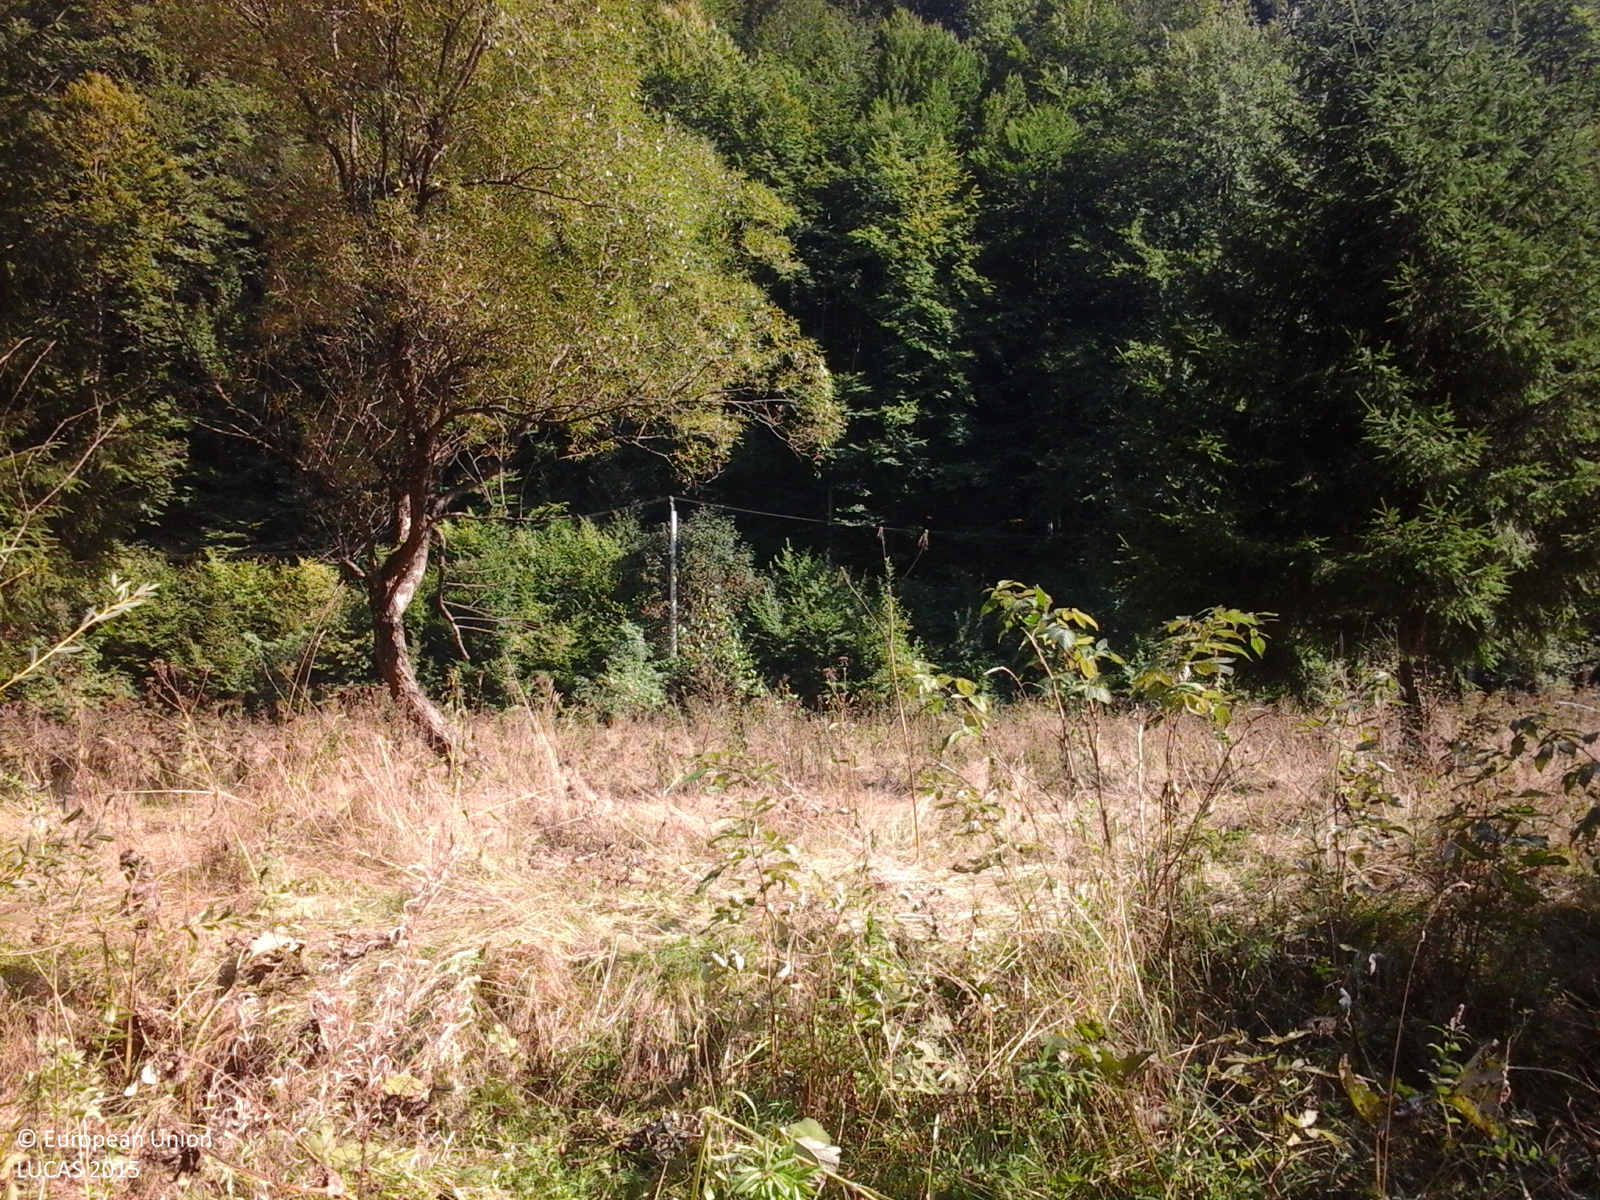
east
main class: Woodland
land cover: Other mixed woodland
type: acidophilous oak and oak-birch forest
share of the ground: > 75 %
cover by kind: broadleaved forest trees 75 %, coniferous forest trees 25 %
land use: Forestry
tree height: > 5 m
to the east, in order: Other mixed woodland; Inland fresh running water; Grassland with sparse tree/shrub cover; Paved roads, cycling and walking lanes; Broadleaved woodland; Electric lines; Broadleaved woodland
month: September
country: RO
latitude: 46.7556
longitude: 22.5563
